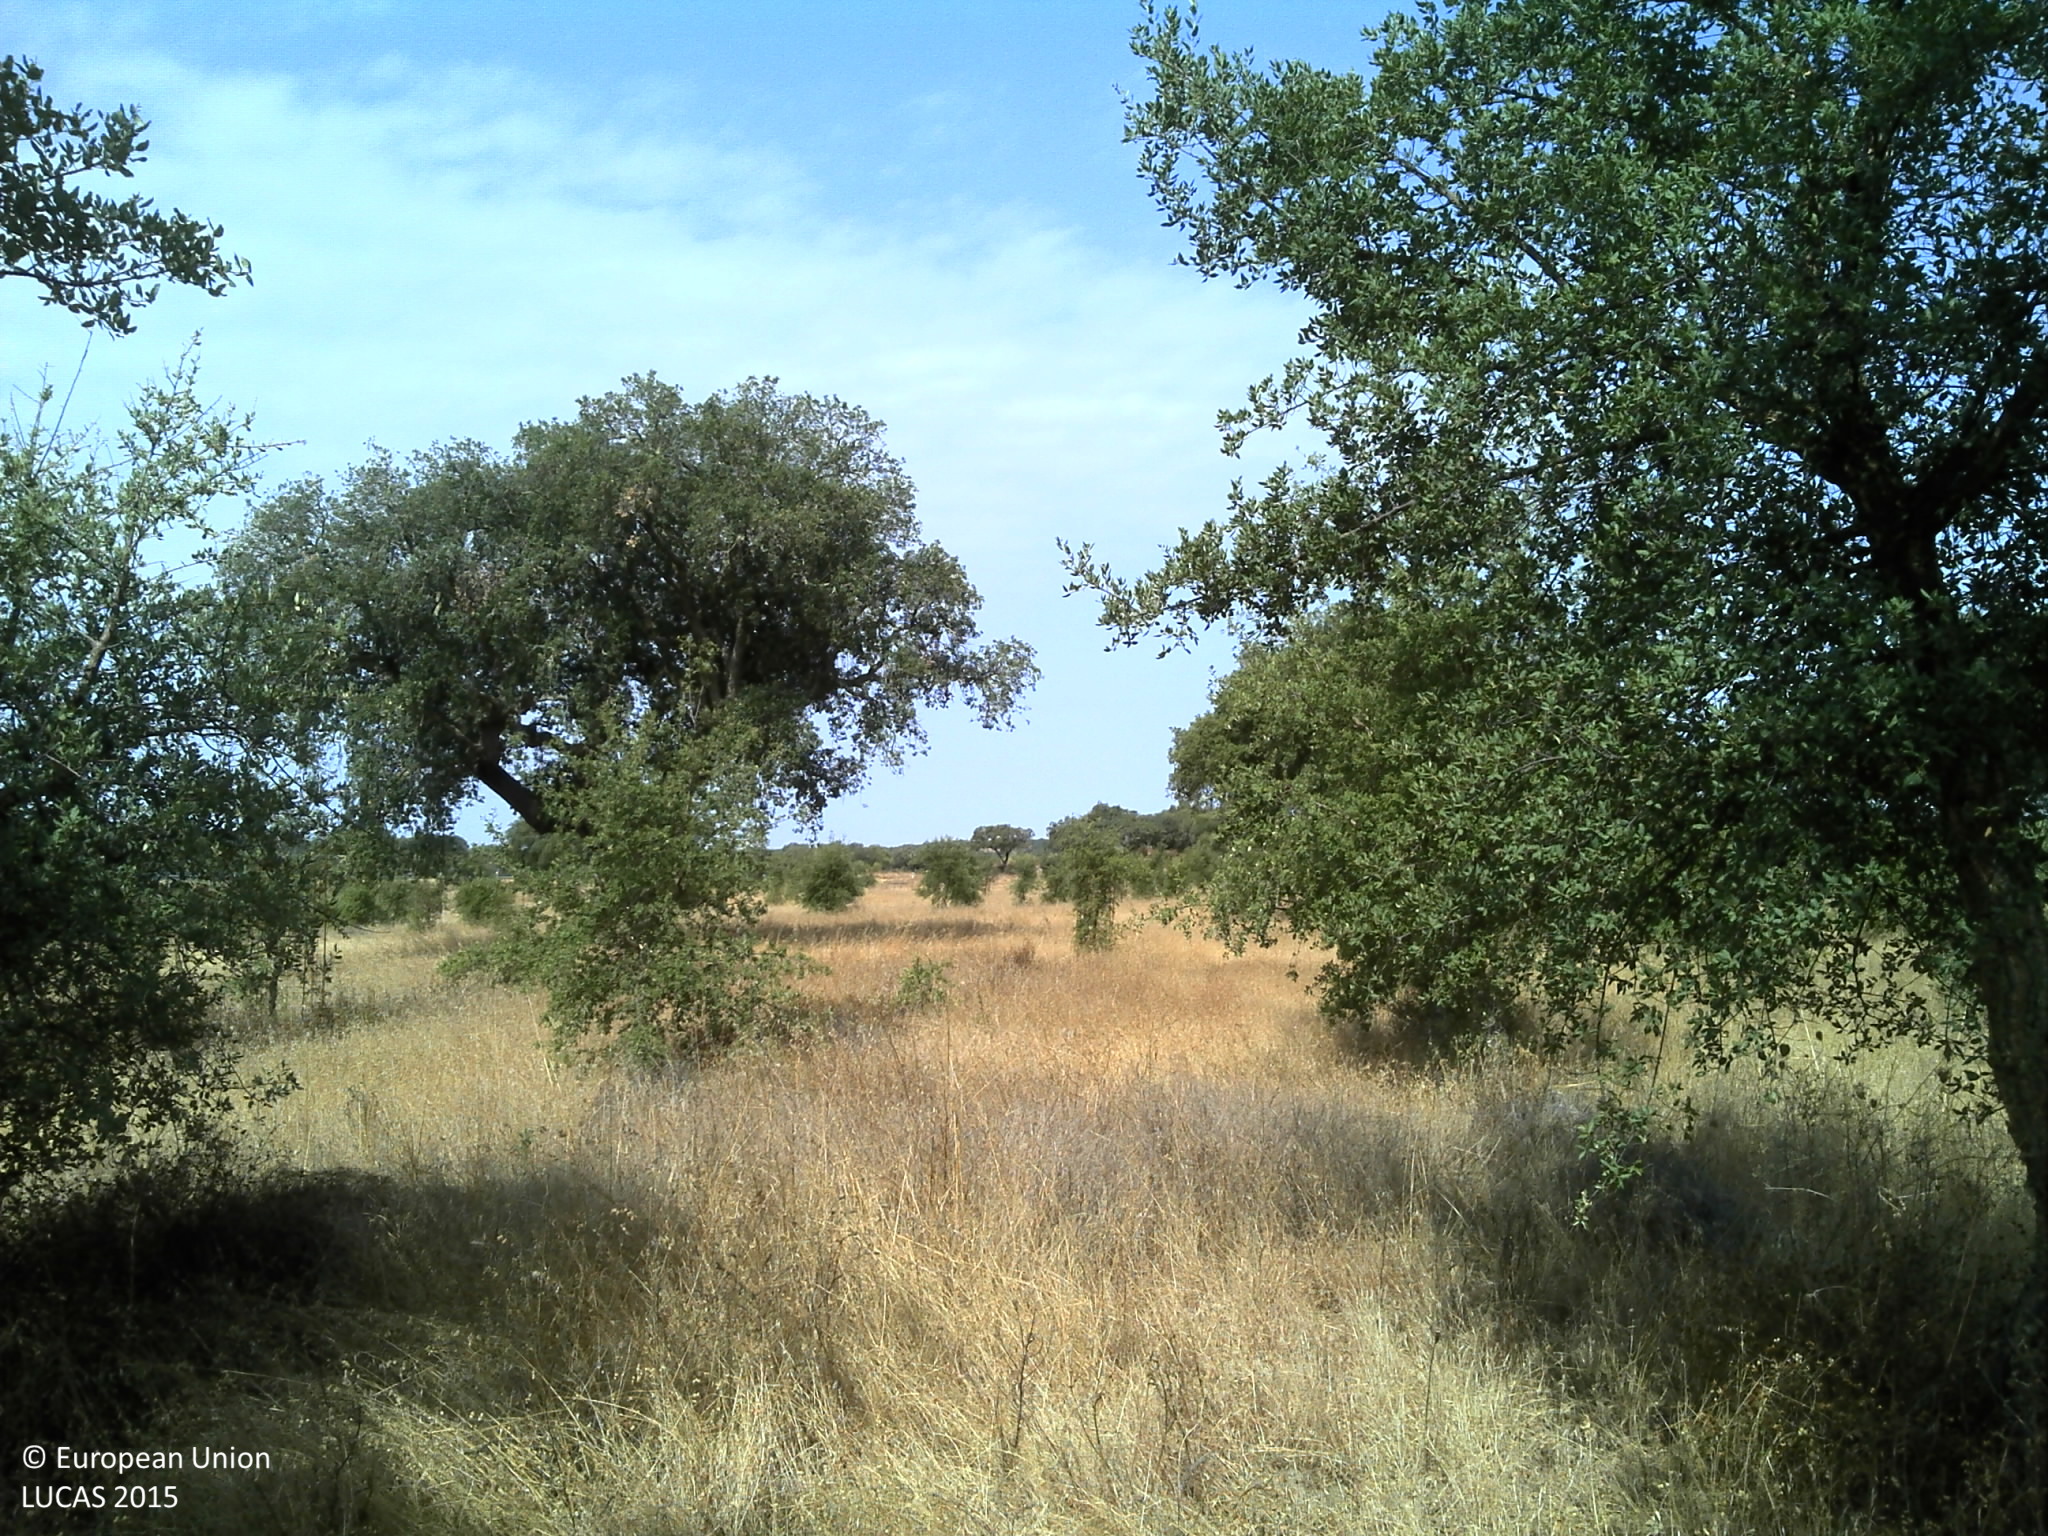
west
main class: Woodland
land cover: Broadleaved woodland
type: broadleaved evergreen forest
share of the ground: 10 - 25 %
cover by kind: herbaceous plants 50 %, unconsolidated bare surface 35 %, broadleaved forest trees 15 %
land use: Forestry
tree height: < 5 m
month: August
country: PT
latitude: 39.2830
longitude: -7.5376
